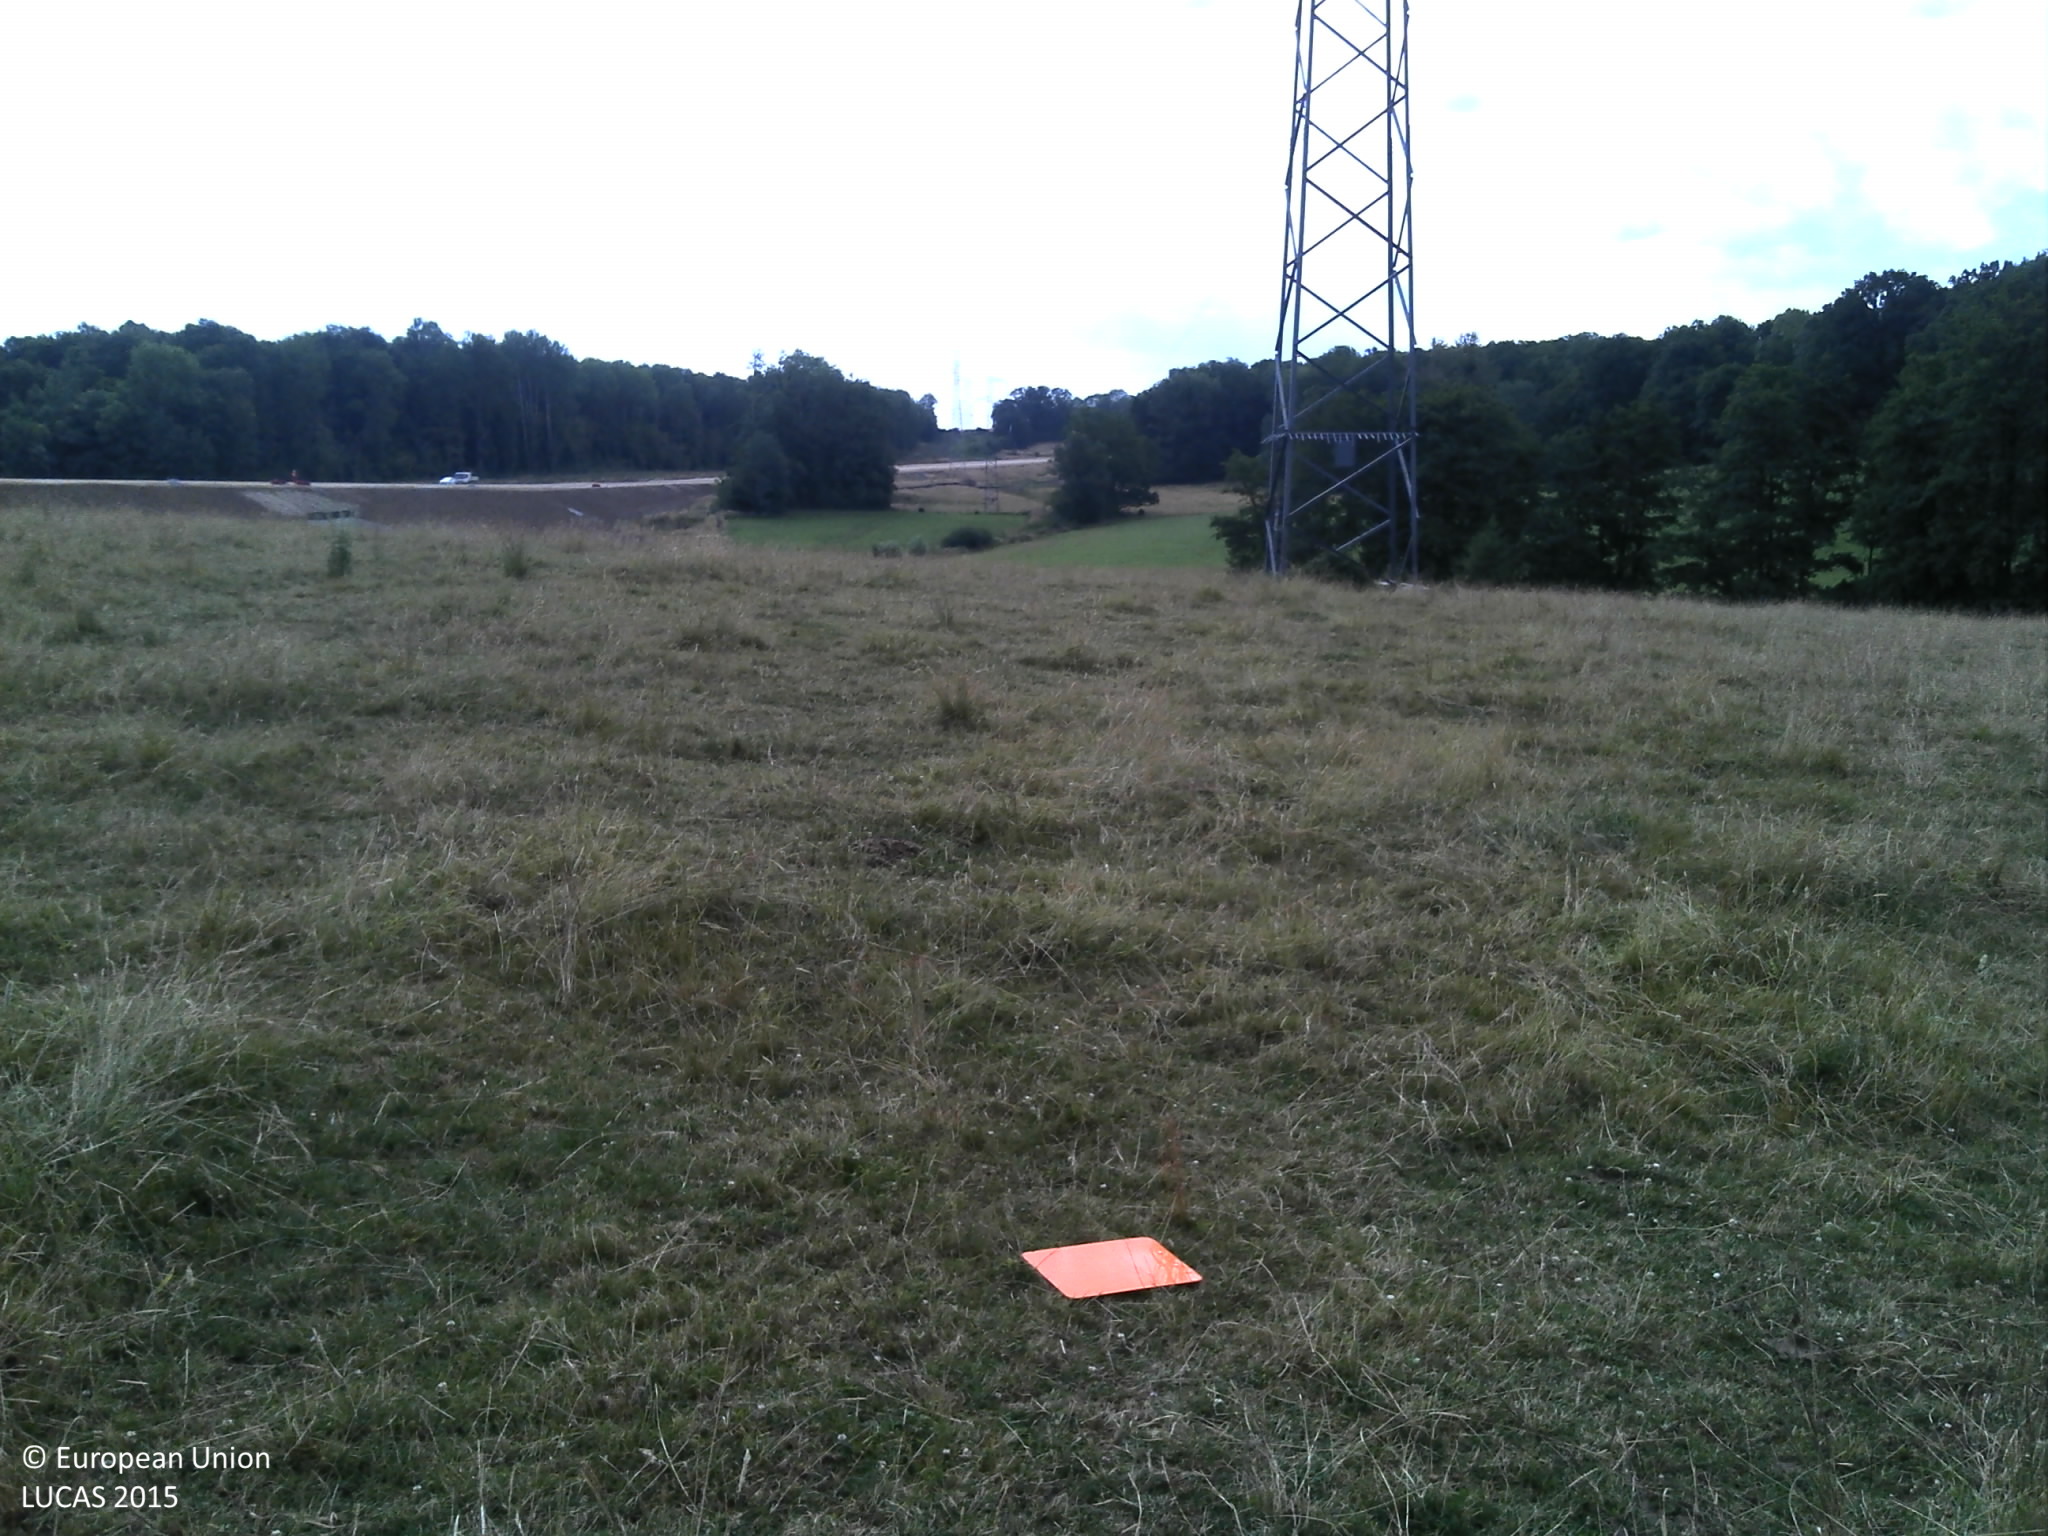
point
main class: Grassland
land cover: Grassland without tree/shrub cover
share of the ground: > 75 %
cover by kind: herbaceous plants 100 %
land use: Agriculture (excluding fallow land and kitchen gardens)
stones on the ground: < 10 %
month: July
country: FR
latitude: 49.7358
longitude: 4.6825
